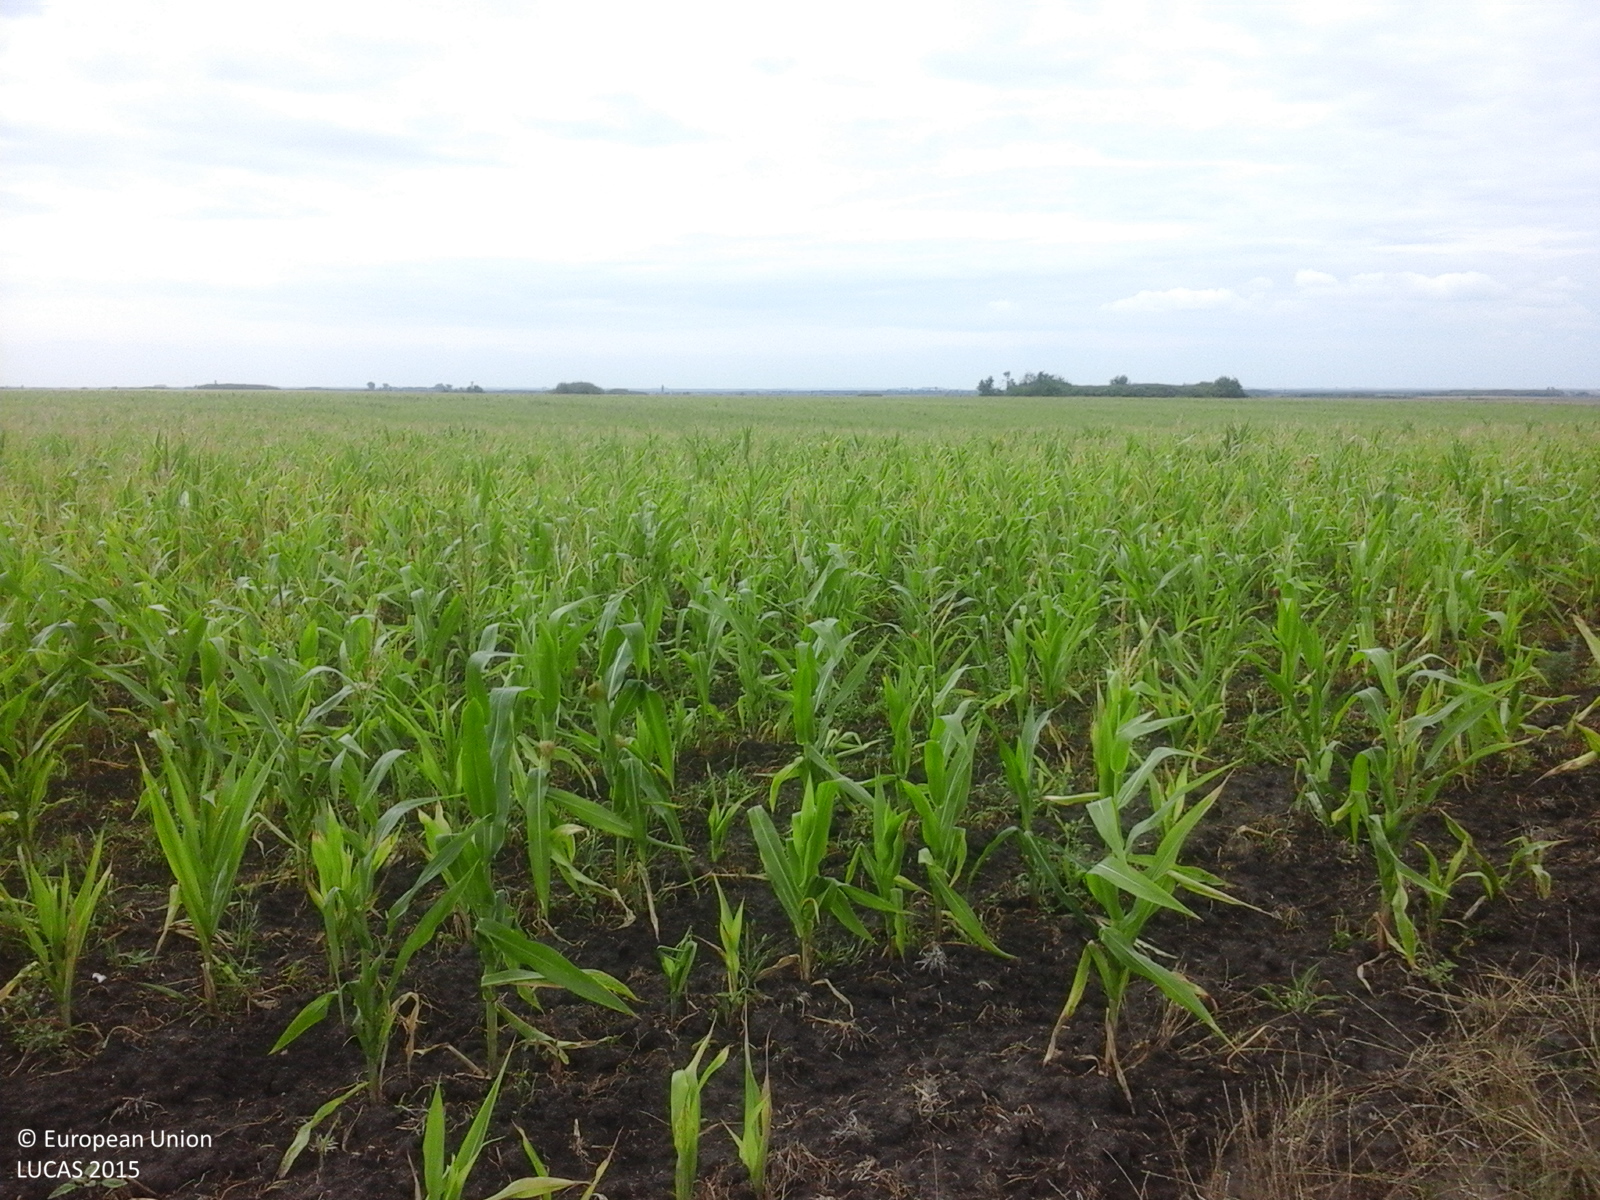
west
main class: Grassland
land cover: Grassland without tree/shrub cover
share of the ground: > 75 %
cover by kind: herbaceous plants 100 %
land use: Agriculture (excluding fallow land and kitchen gardens)
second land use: Sport
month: August
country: RO
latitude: 45.4571
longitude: 21.3217
